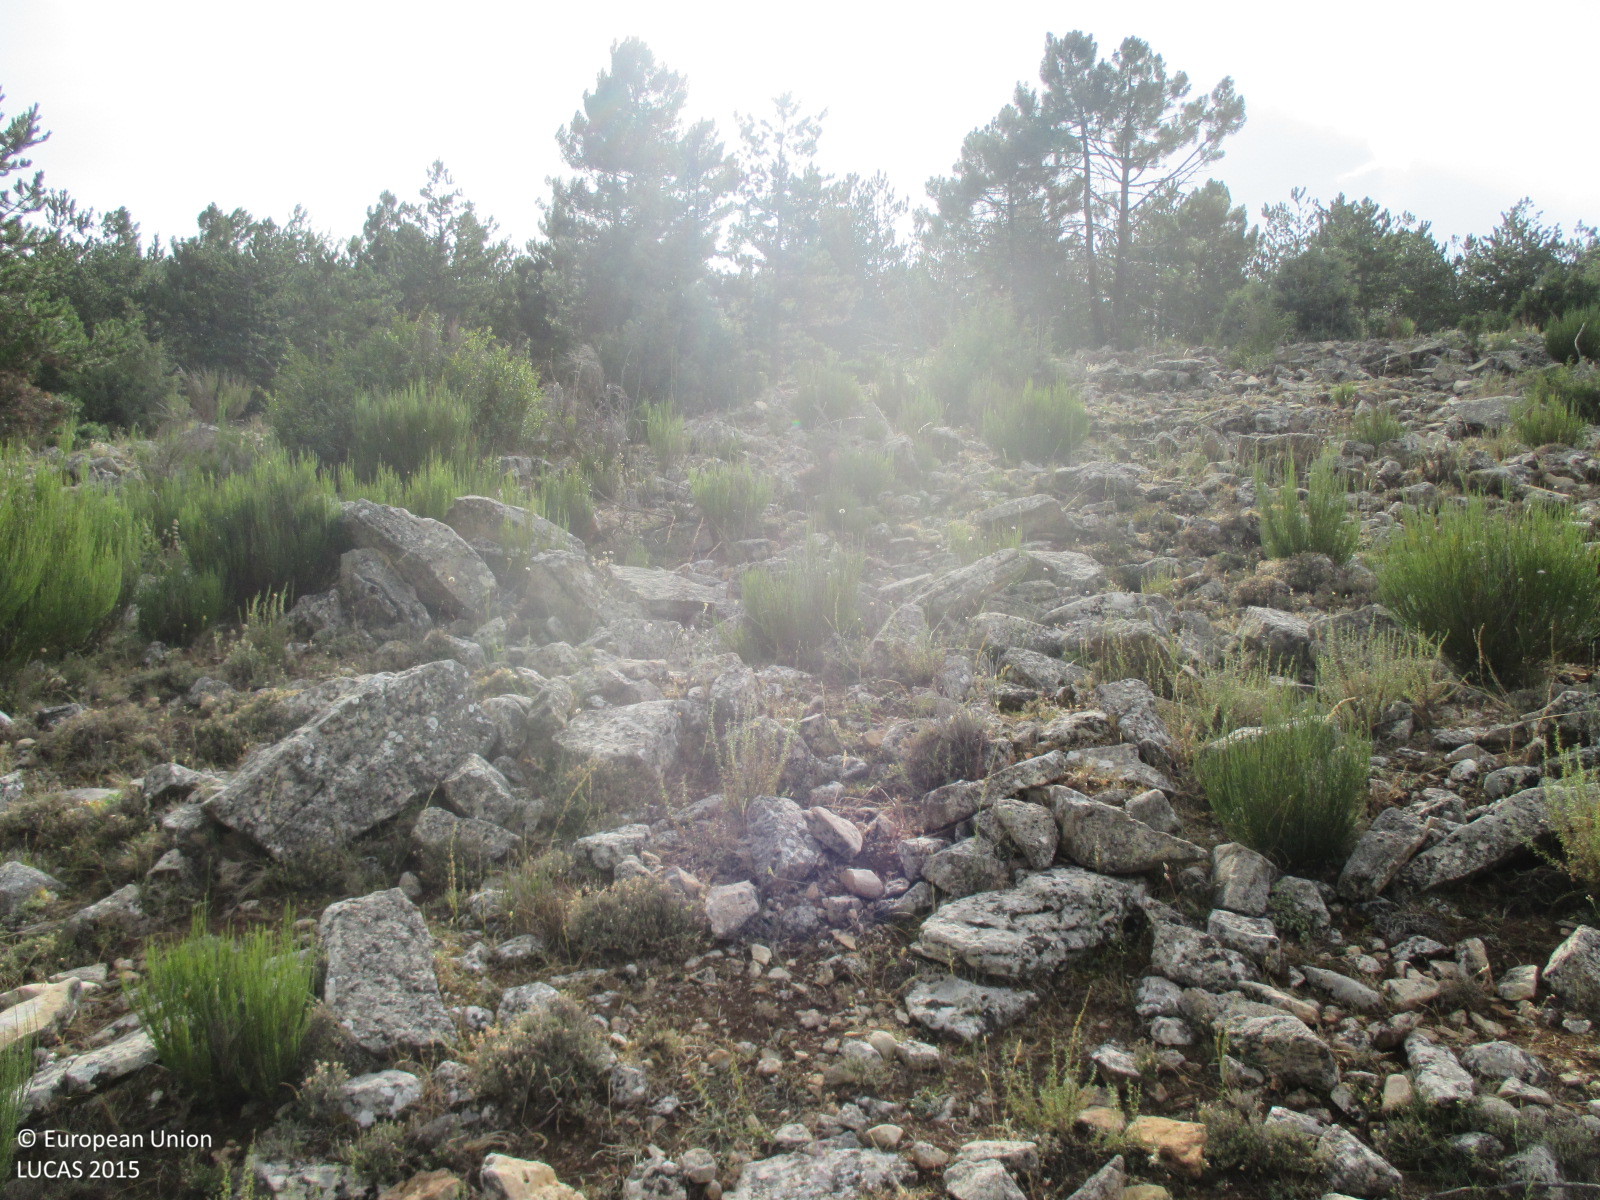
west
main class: Shrubland
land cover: Shrubland with sparse tree cover
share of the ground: 50 - 75 %
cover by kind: shrubs 60 %, herbaceous plants 35 %, coniferous forest trees 5 %
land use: Semi-natural and natural areas not in use
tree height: < 5 m
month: July
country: ES
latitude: 38.1571
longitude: -2.4219
